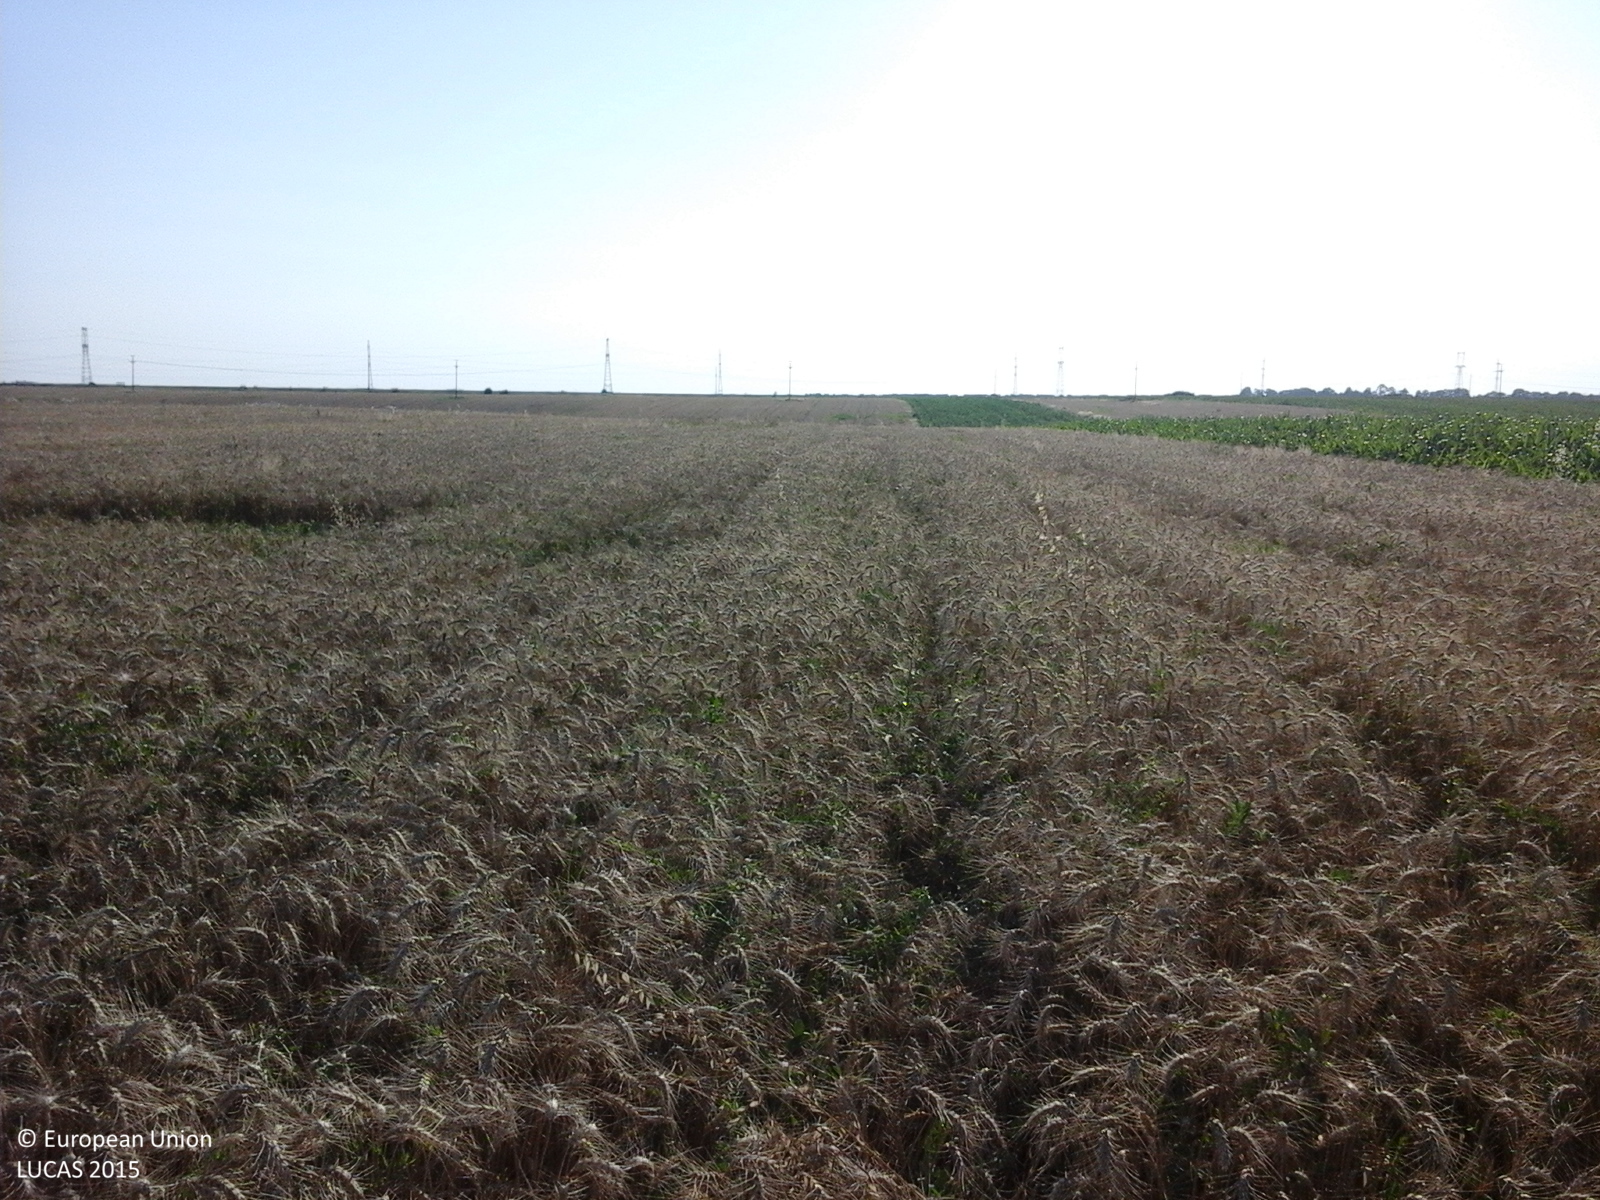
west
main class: Cropland
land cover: Common wheat
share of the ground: > 75 %
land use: Agriculture (excluding fallow land and kitchen gardens)
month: July
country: RO
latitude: 44.3210
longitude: 24.4504
